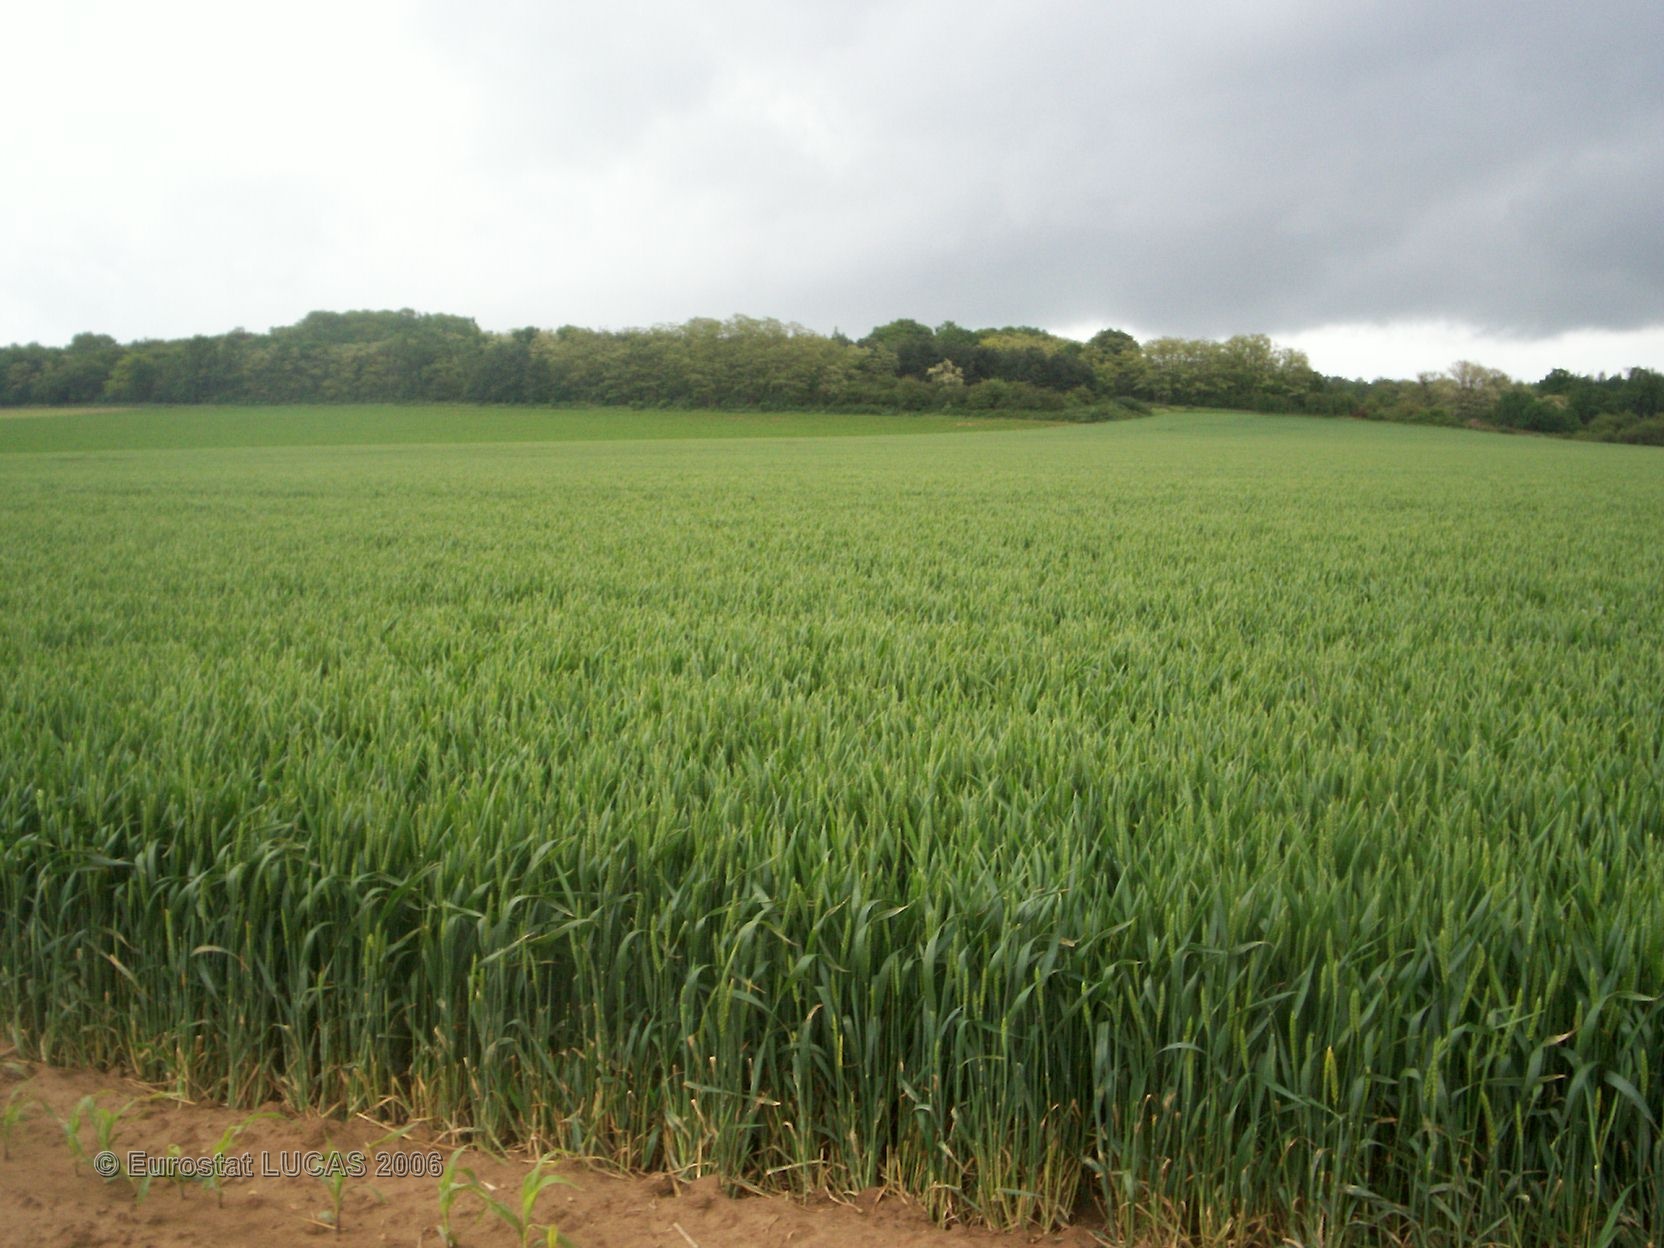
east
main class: Cropland
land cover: Maize
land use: Agriculture (excluding fallow land and kitchen gardens)
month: May
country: FR
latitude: 49.2491
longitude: 2.7498
